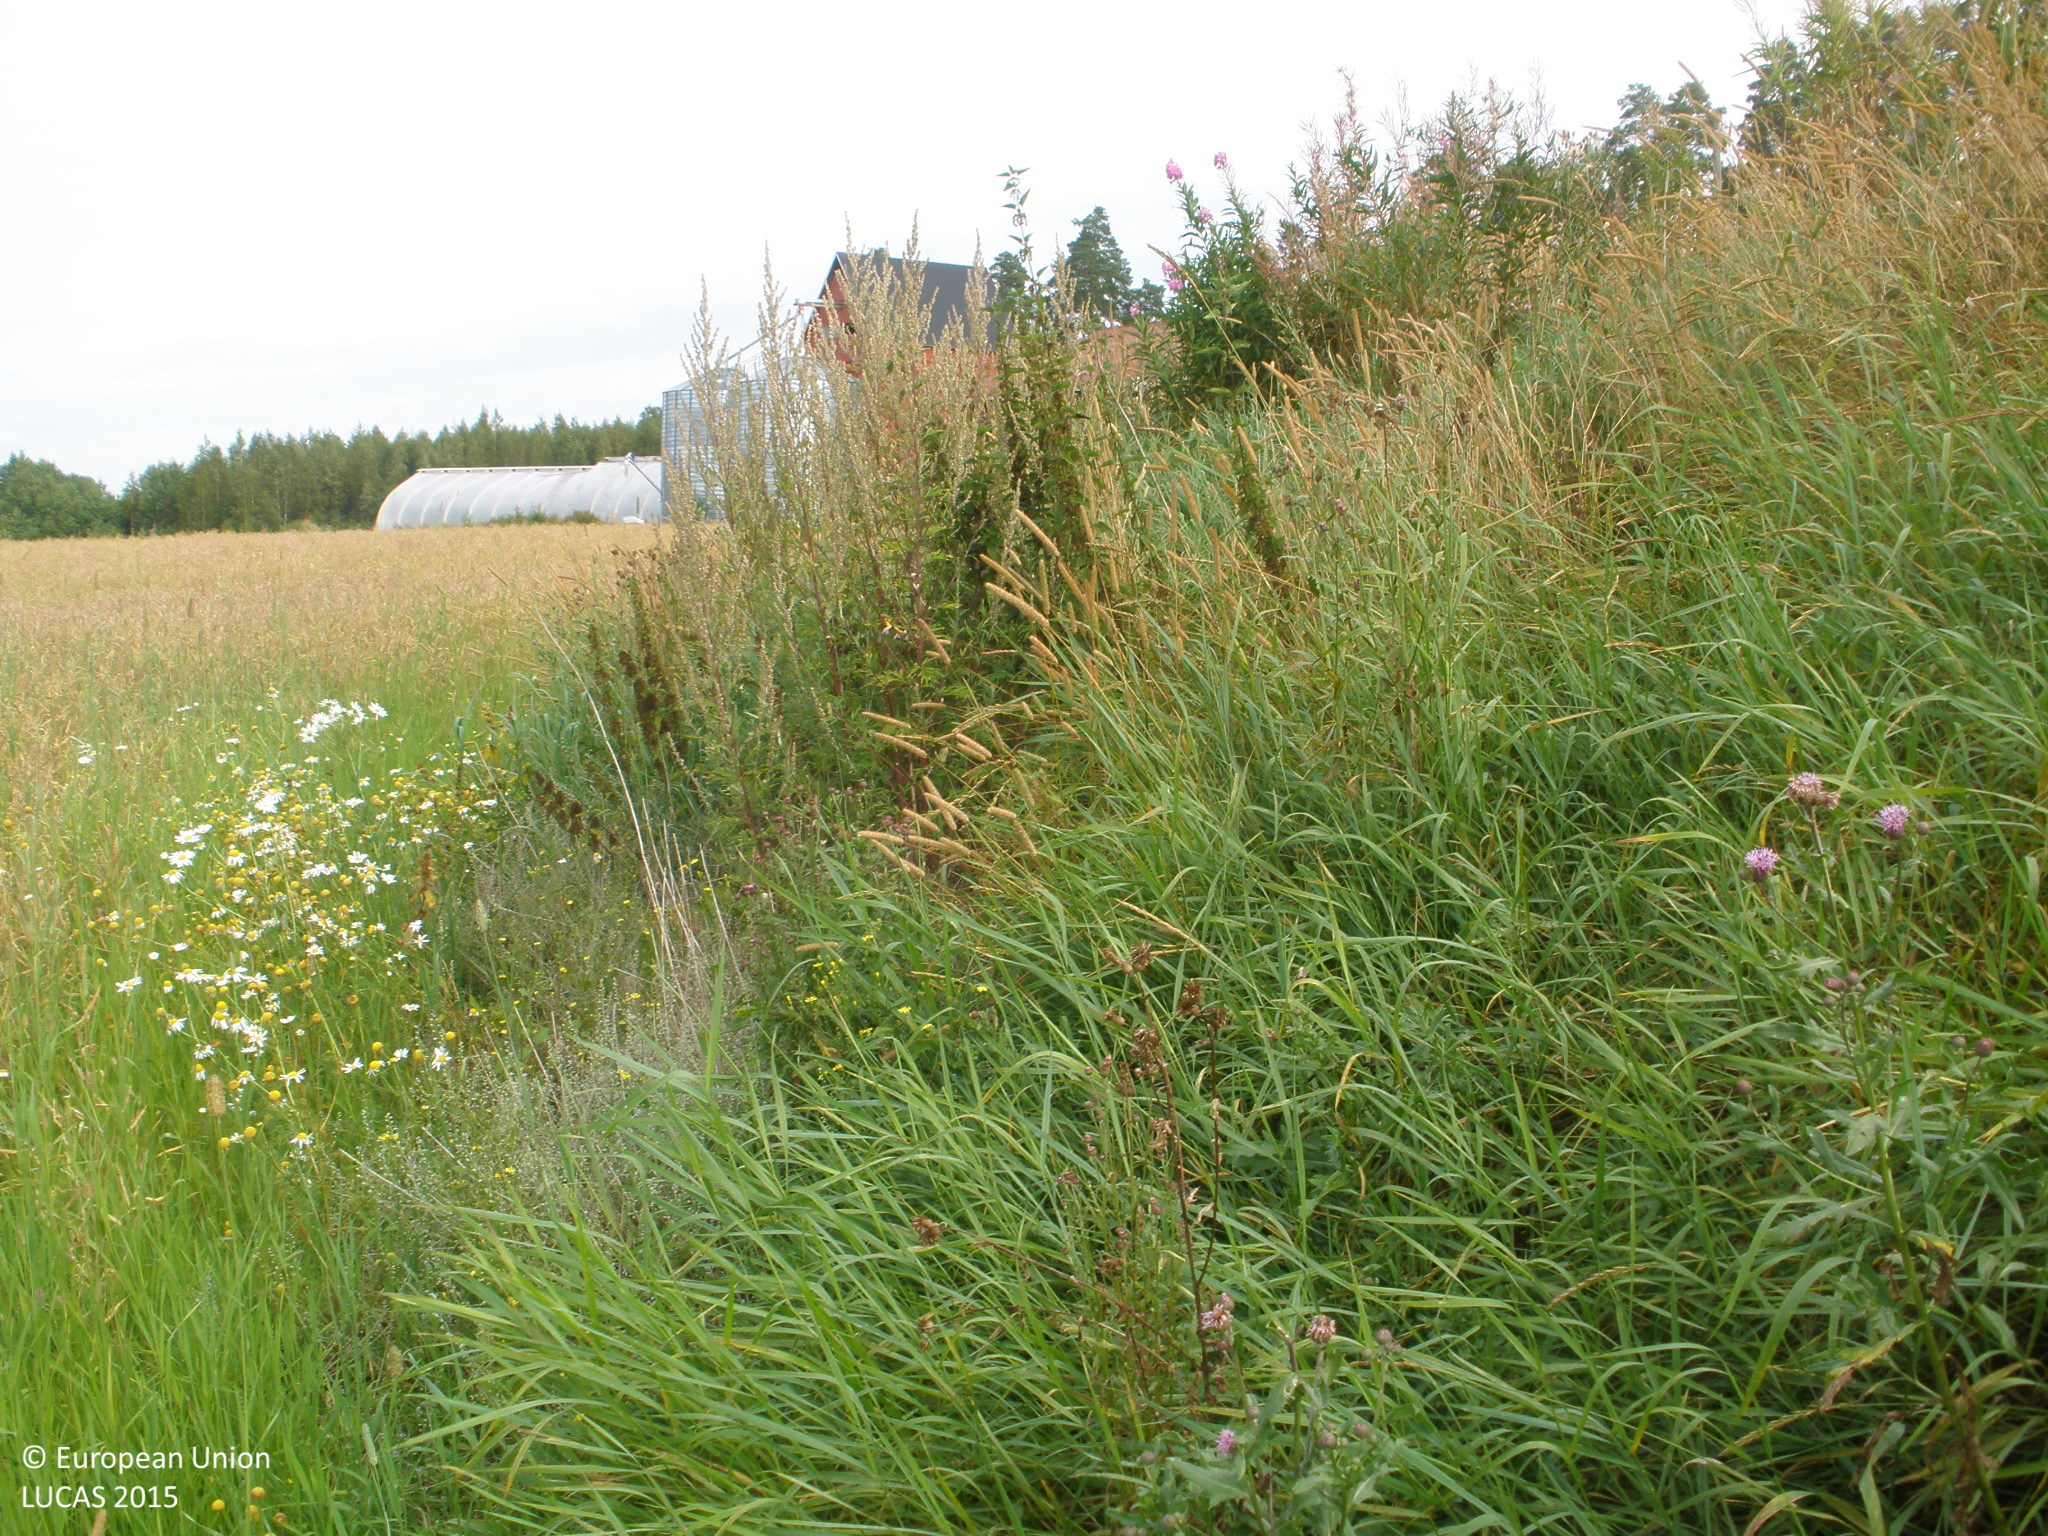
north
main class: Cropland
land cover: Dry pulses
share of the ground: > 75 %
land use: Agriculture (excluding fallow land and kitchen gardens)
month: August
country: FI
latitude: 60.5607
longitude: 23.4179
